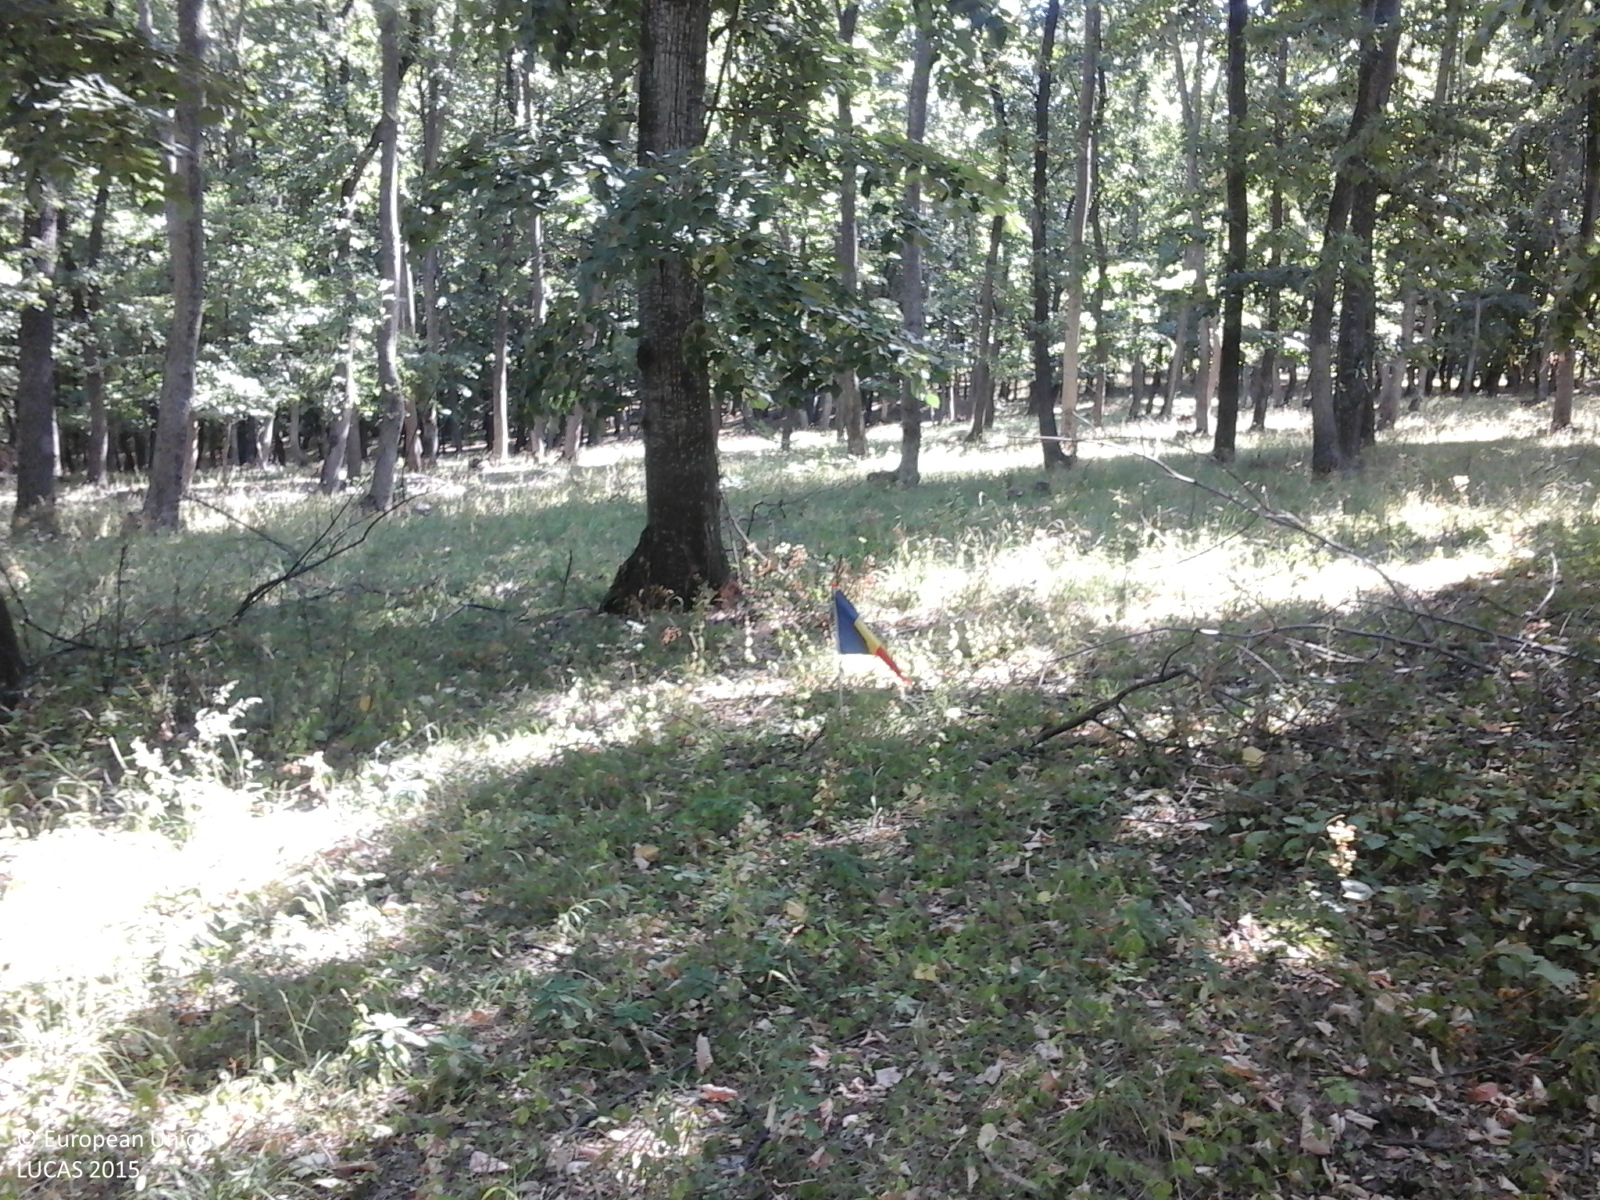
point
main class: Woodland
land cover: Broadleaved woodland
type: mesophytic deciduous forest
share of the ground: > 75 %
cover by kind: broadleaved forest trees 100 %
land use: Forestry
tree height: > 5 m
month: July
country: RO
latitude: 45.9999
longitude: 27.7128
